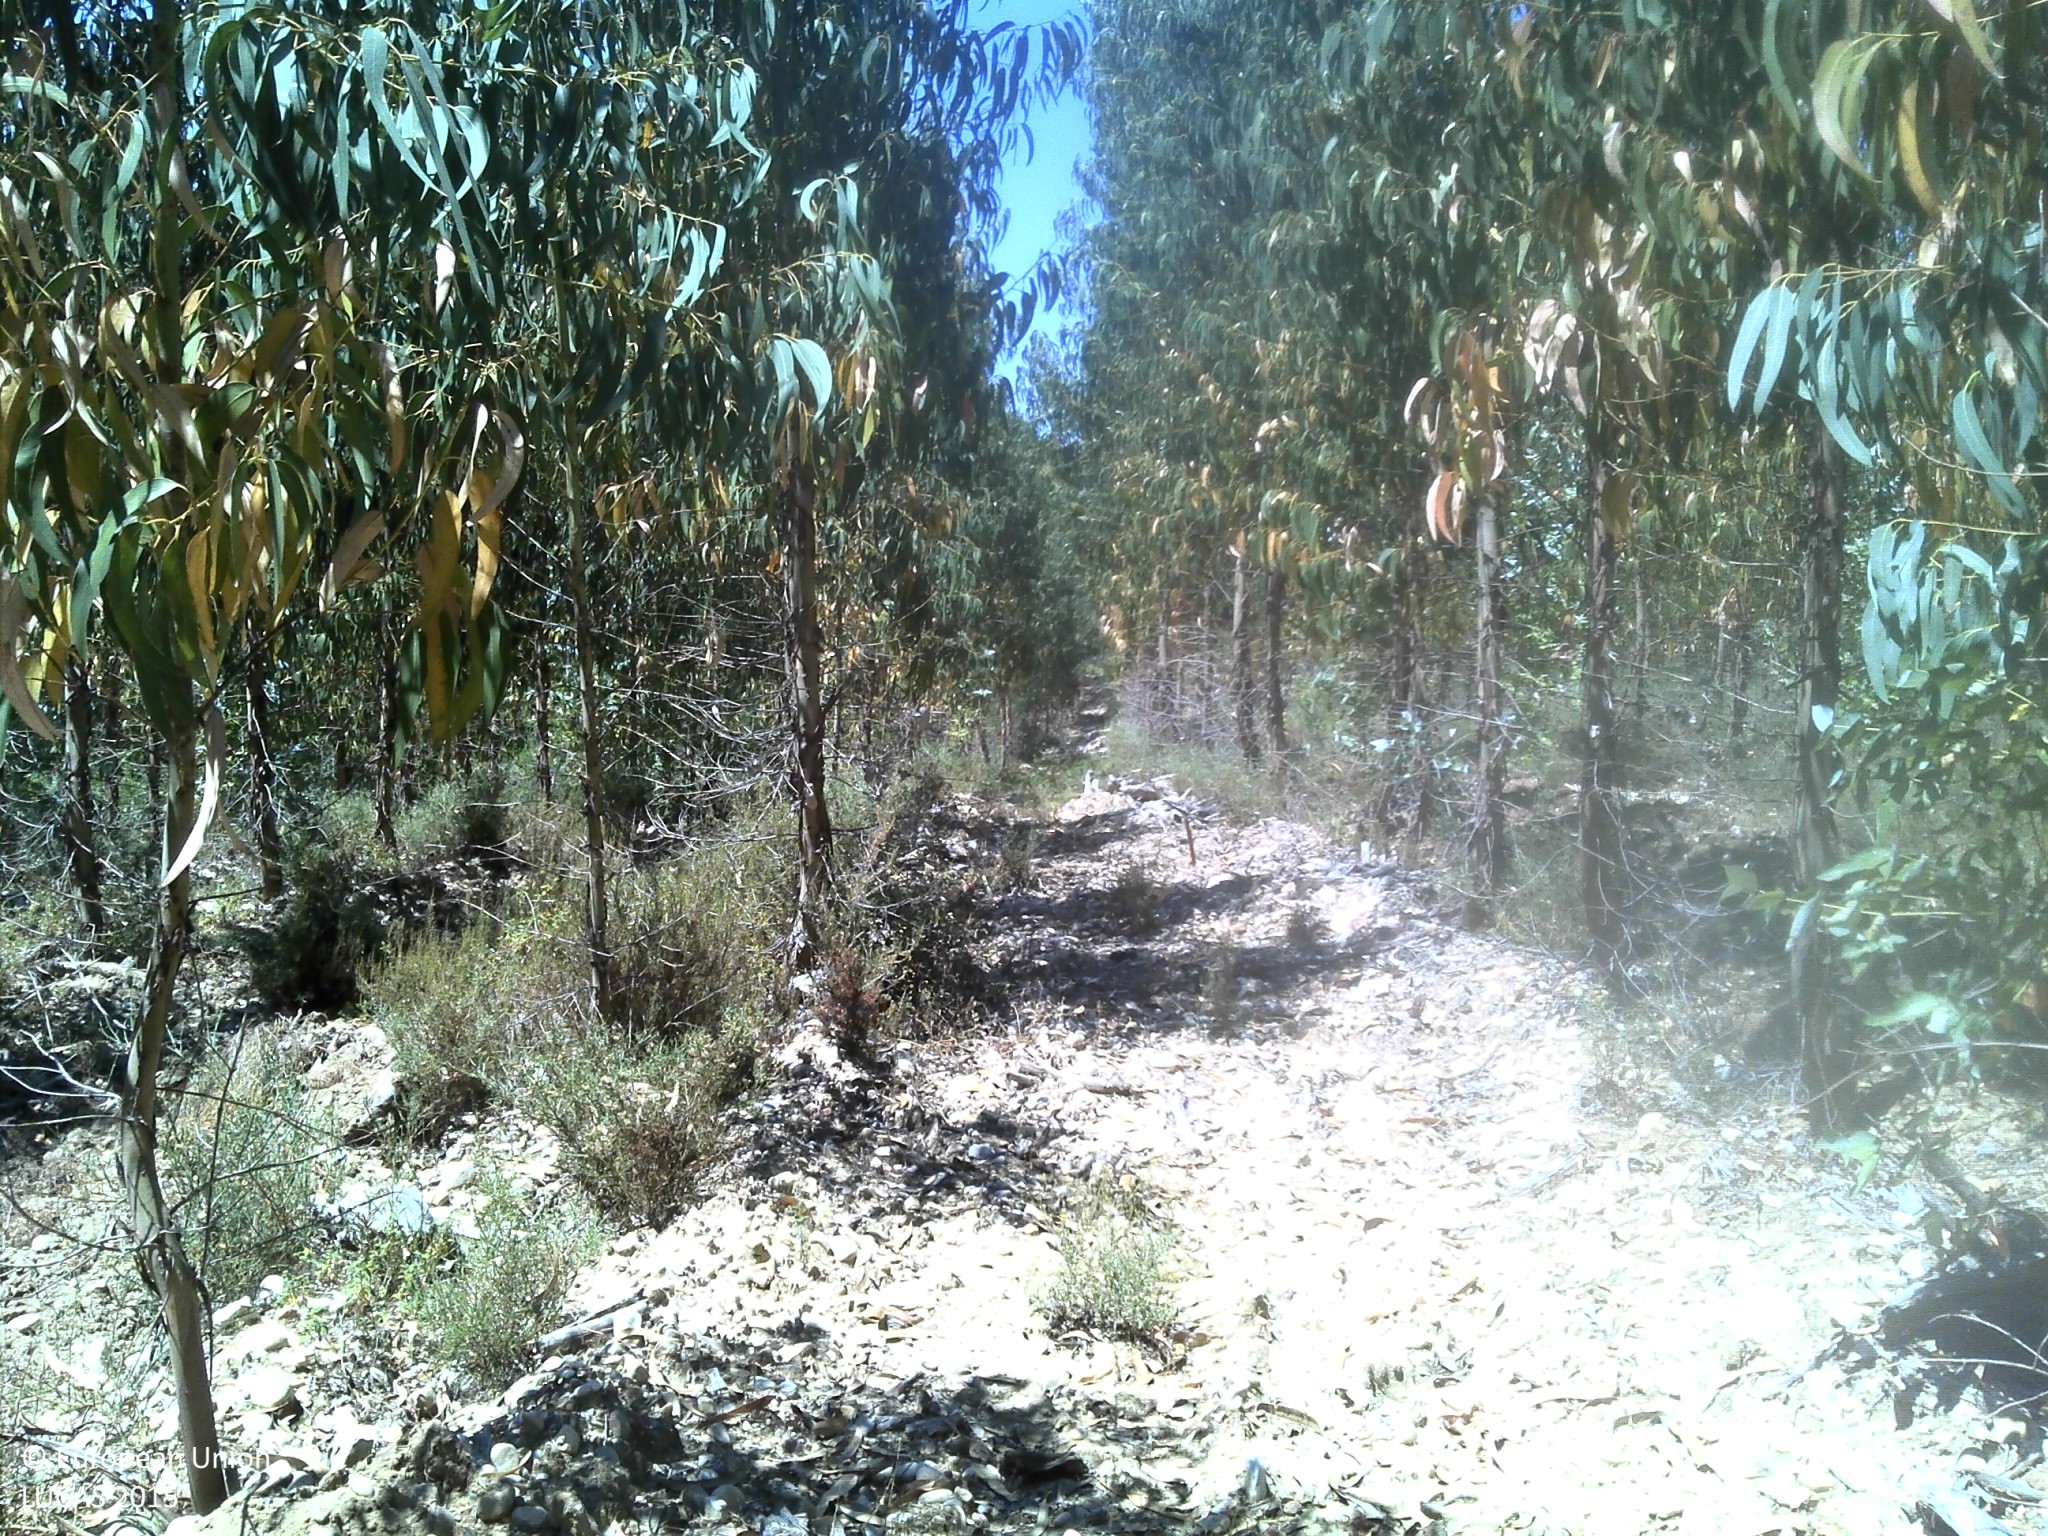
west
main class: Woodland
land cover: Broadleaved woodland
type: exotic forest
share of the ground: 25 - 50 %
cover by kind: broadleaved forest trees 60 %, shrubs 20 %, herbaceous plants 20 %
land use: Forestry
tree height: > 5 m
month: May
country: PT
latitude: 39.3622
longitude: -8.2976
